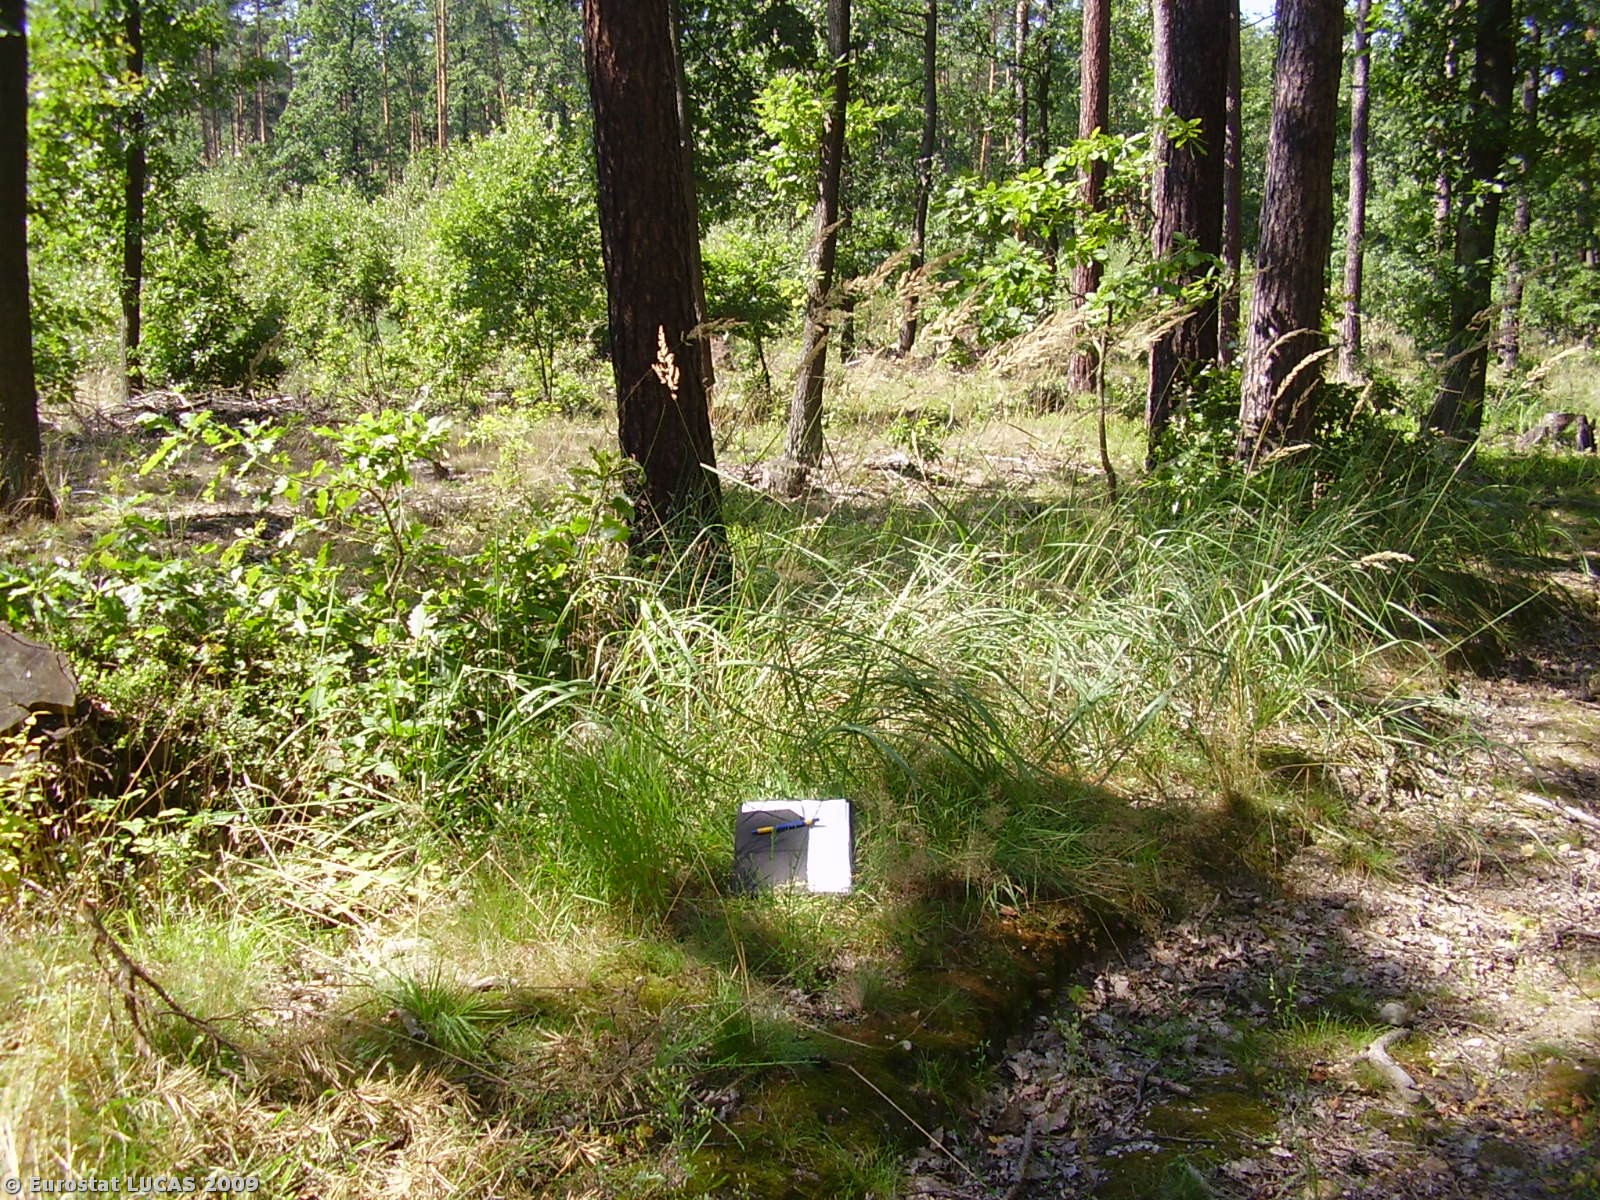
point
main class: Woodland
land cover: Mixed woodland
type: hemiboreal forest and nemoral coniferous forest and mixed broadleaved-coniferous forest
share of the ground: > 75 %
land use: Forestry
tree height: > 5 m
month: August
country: PL
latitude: 51.3175
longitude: 16.1330
